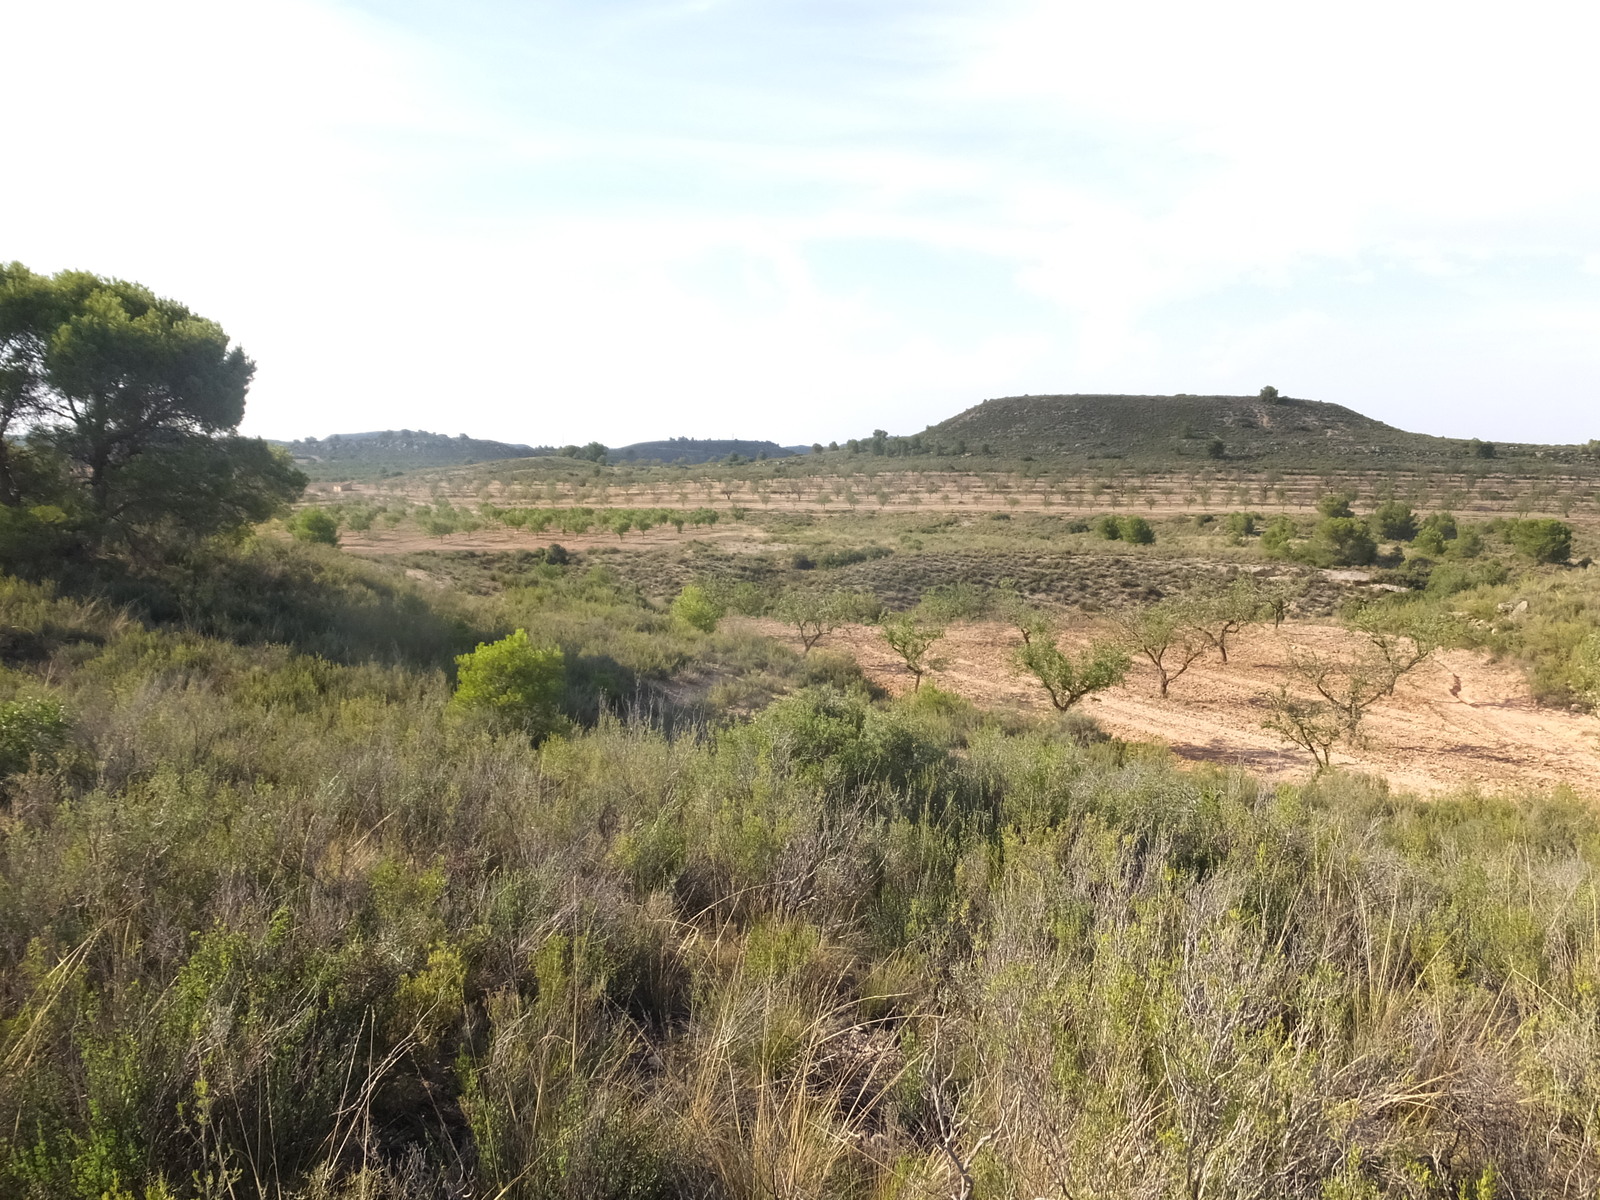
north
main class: Shrubland
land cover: Shrubland with sparse tree cover
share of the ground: > 75 %
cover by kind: shrubs 55 %, herbaceous plants 40 %, coniferous forest trees 5 %
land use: Semi-natural and natural areas not in use
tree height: < 5 m
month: July
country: ES
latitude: 41.1597
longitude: 0.2053
